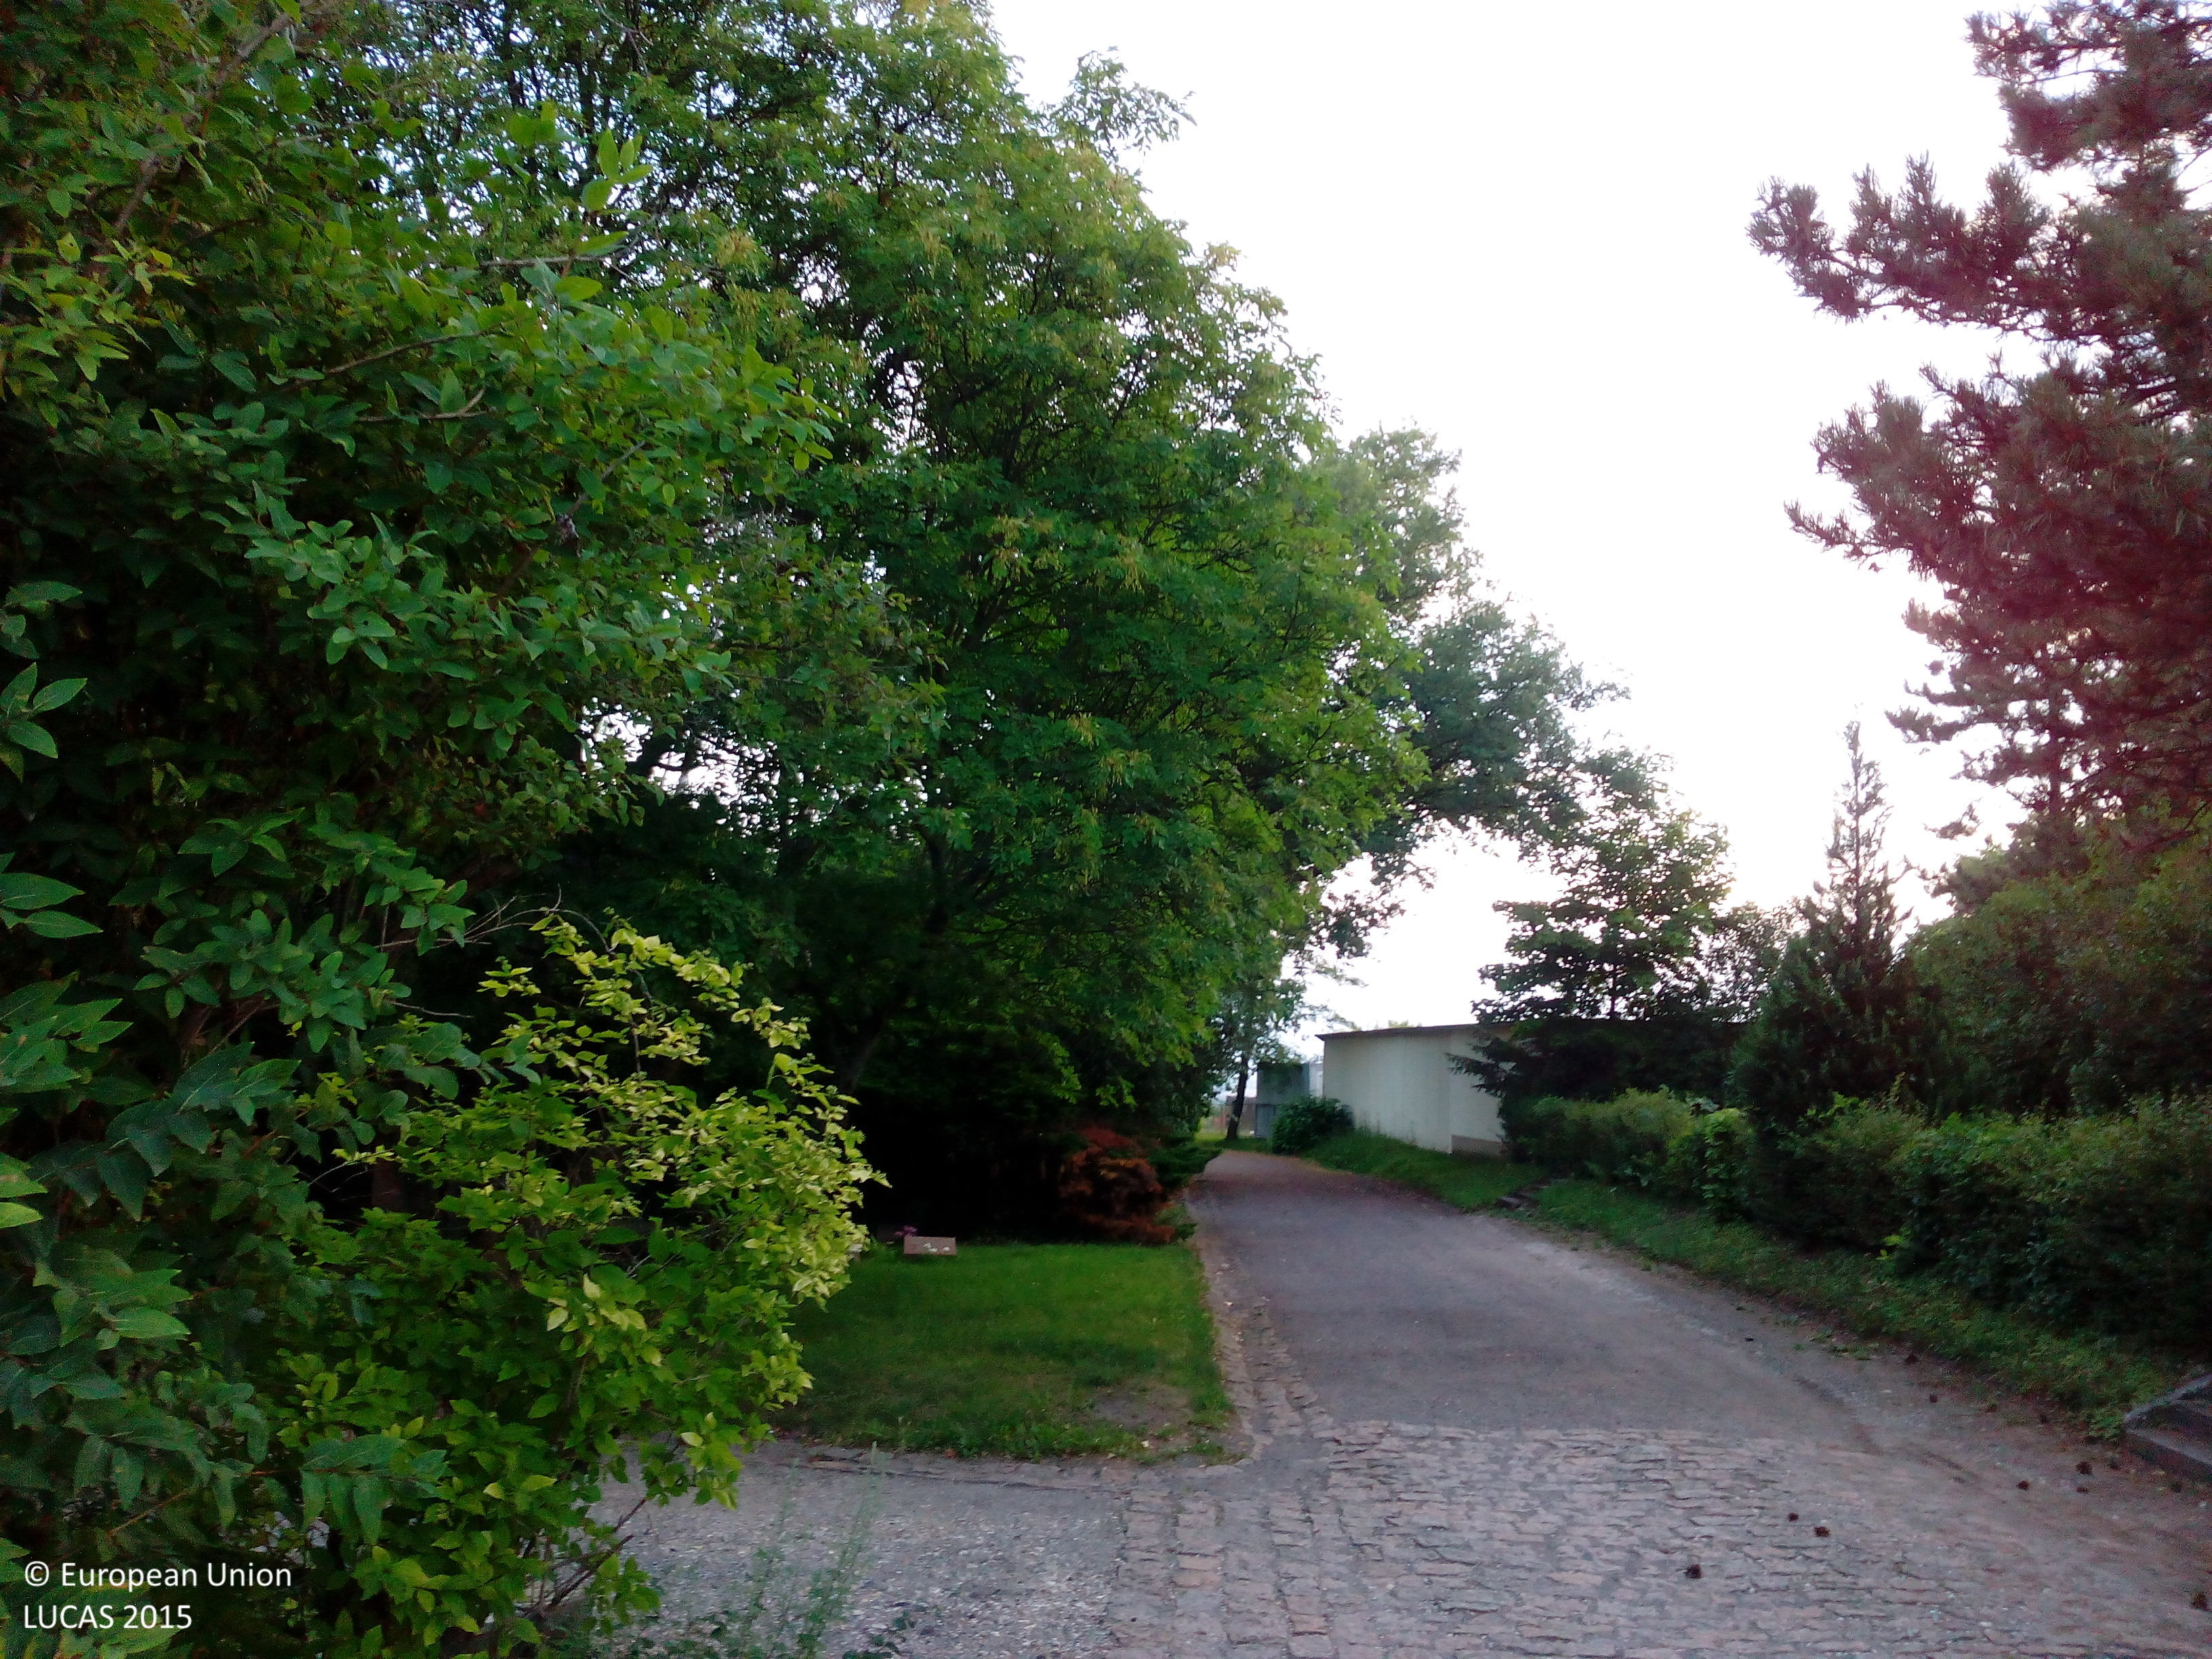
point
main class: Woodland
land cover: Broadleaved woodland
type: mesophytic deciduous forest
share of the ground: 25 - 50 %
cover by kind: broadleaved forest trees 35 %, shrubs 35 %, herbaceous plants 15 %, consolidated bare surface 15 %
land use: Community services
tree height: > 5 m
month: July
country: DE
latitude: 51.0453
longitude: 12.1535
